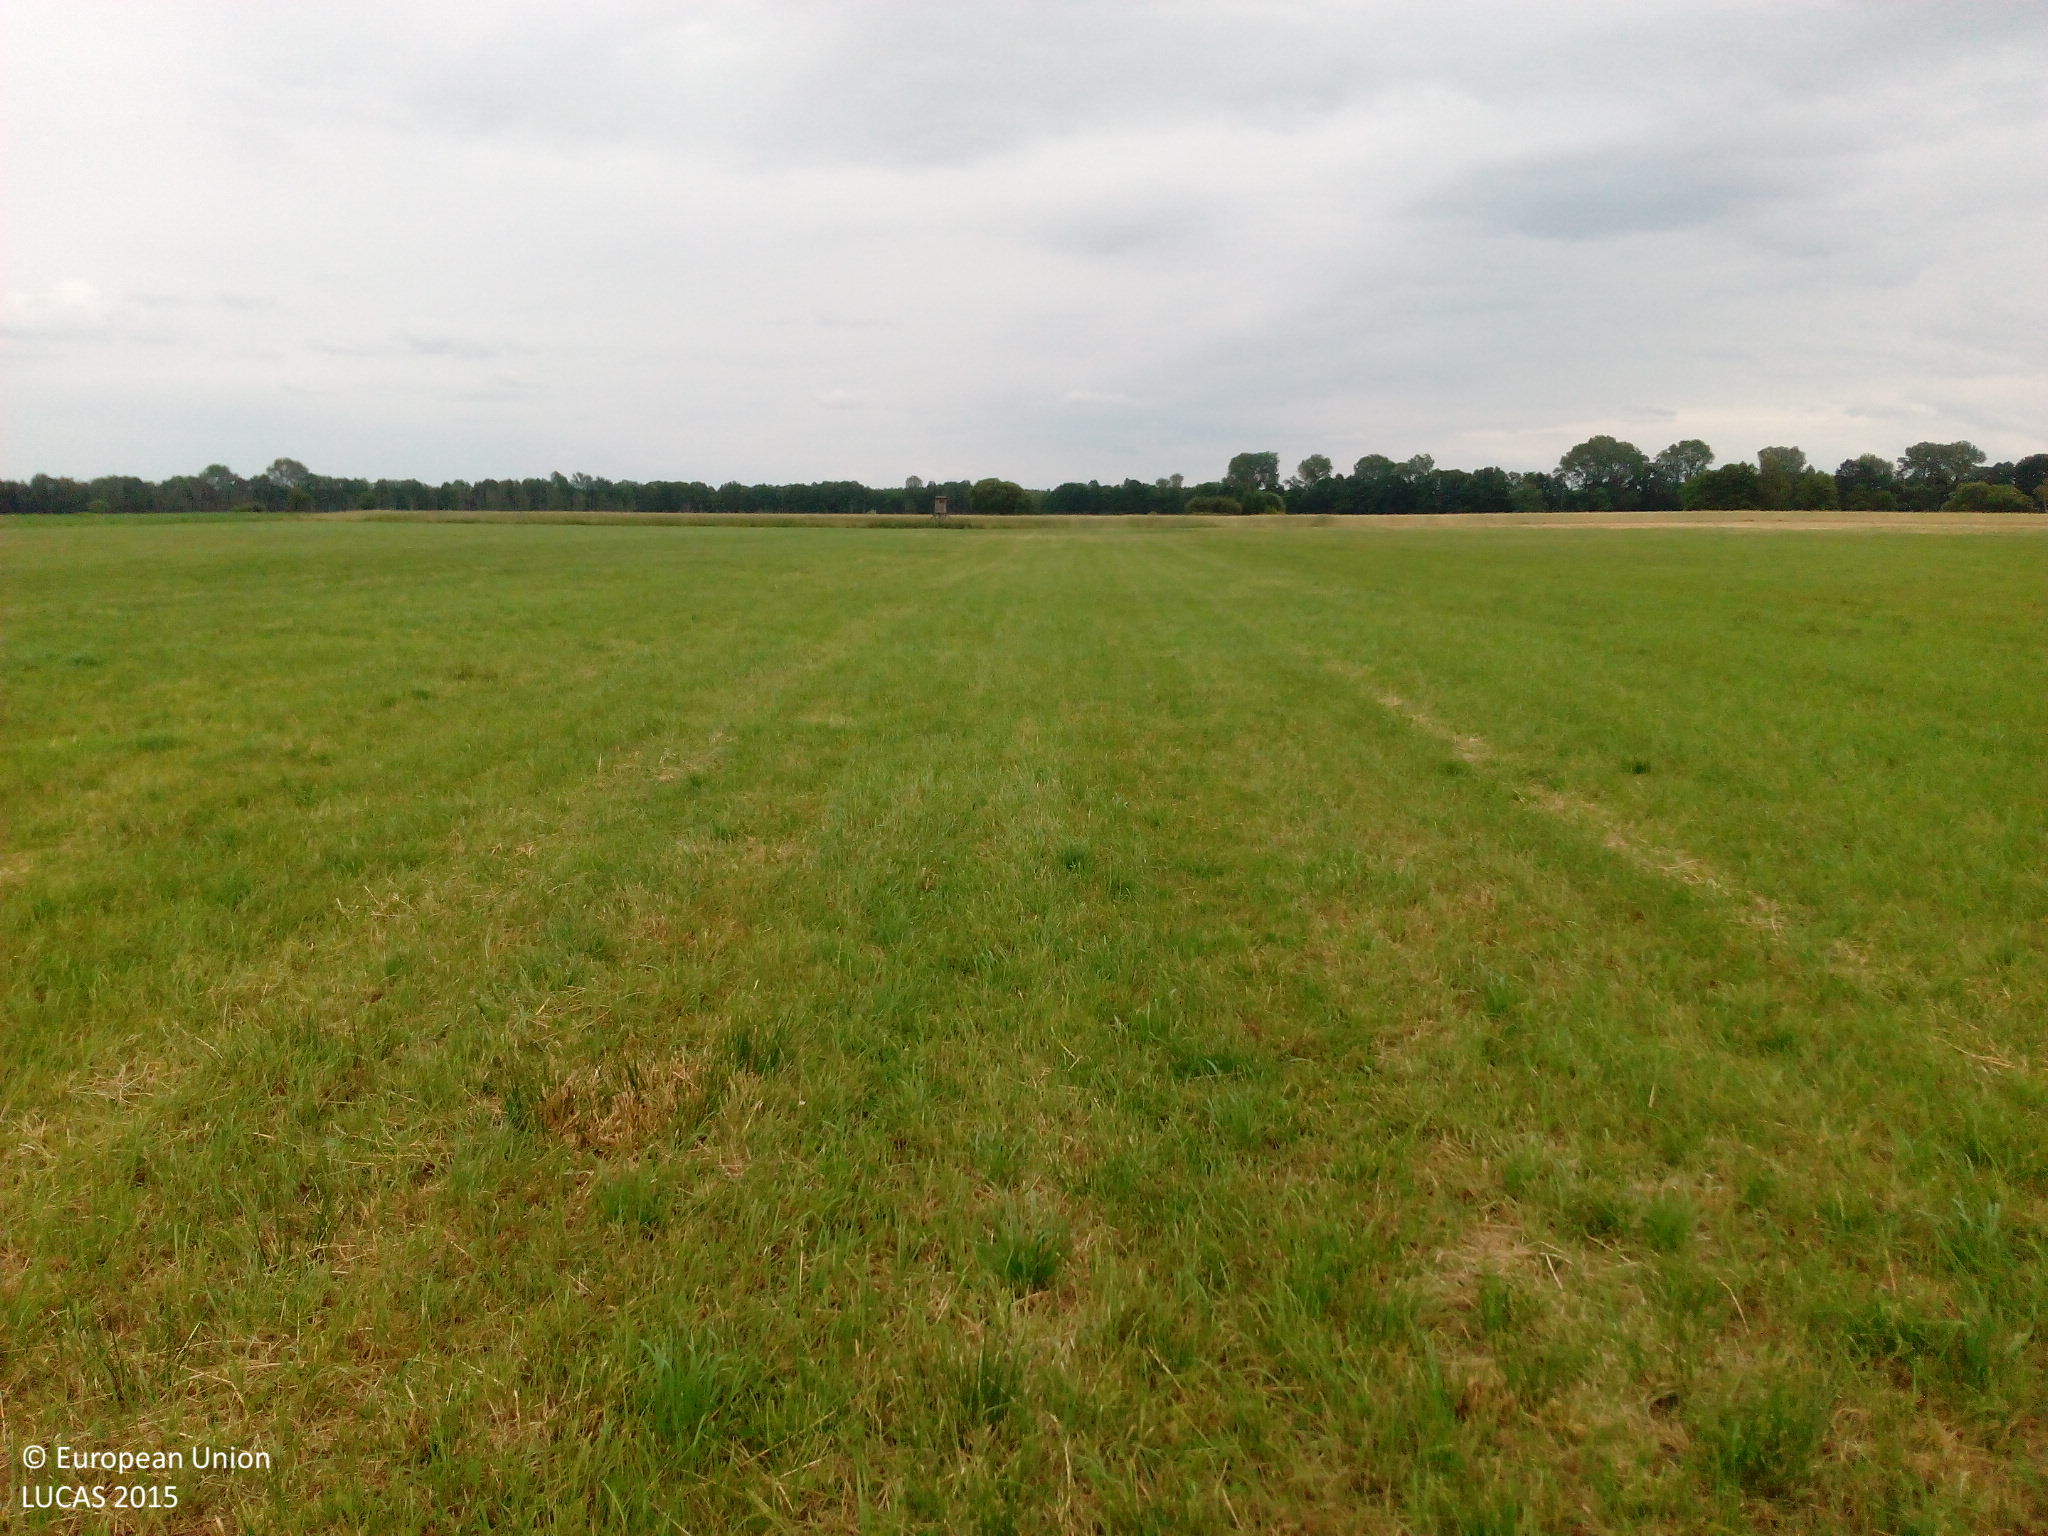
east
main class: Grassland
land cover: Grassland without tree/shrub cover
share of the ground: > 75 %
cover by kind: herbaceous plants 100 %
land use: Agriculture (excluding fallow land and kitchen gardens)
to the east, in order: Grassland without tree/shrub cover; Rye
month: June
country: DE
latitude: 52.3163
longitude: 12.4494
